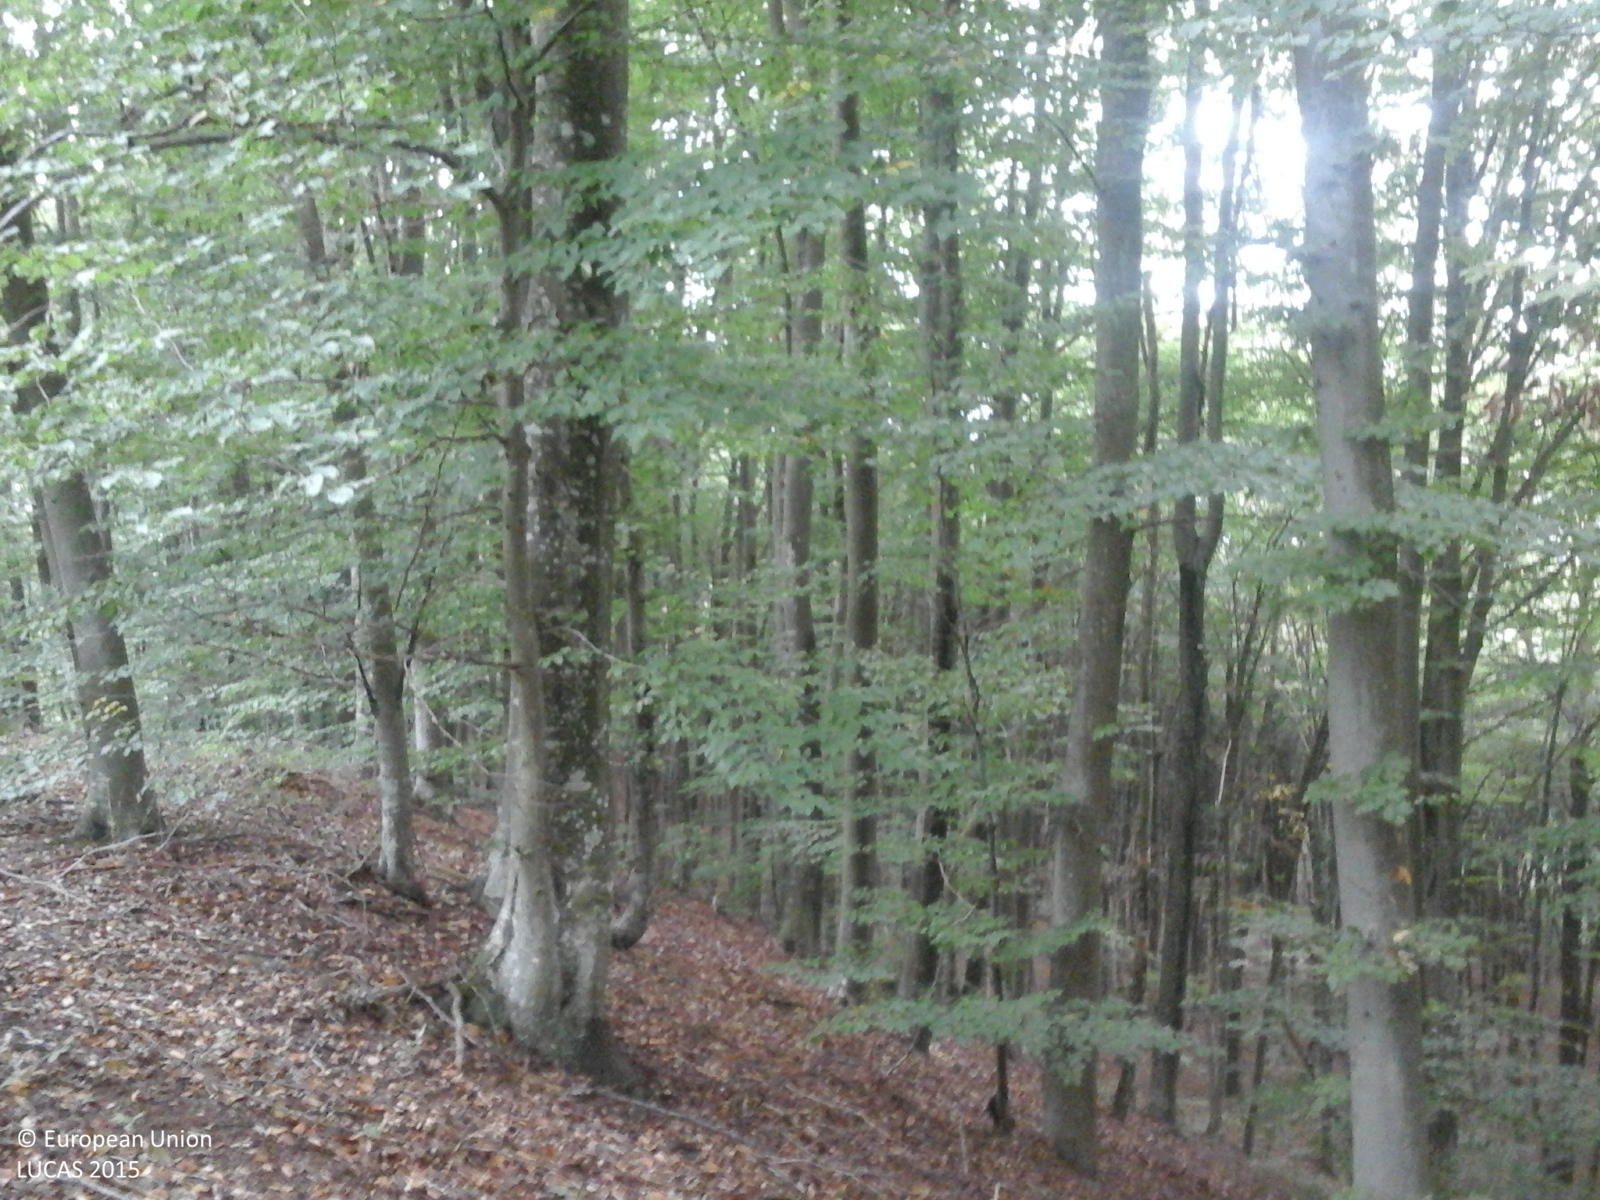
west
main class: Woodland
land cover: Broadleaved woodland
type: beech forest
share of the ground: > 75 %
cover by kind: broadleaved forest trees 100 %
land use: Forestry
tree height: > 5 m
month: September
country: RO
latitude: 45.7748
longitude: 22.2219
